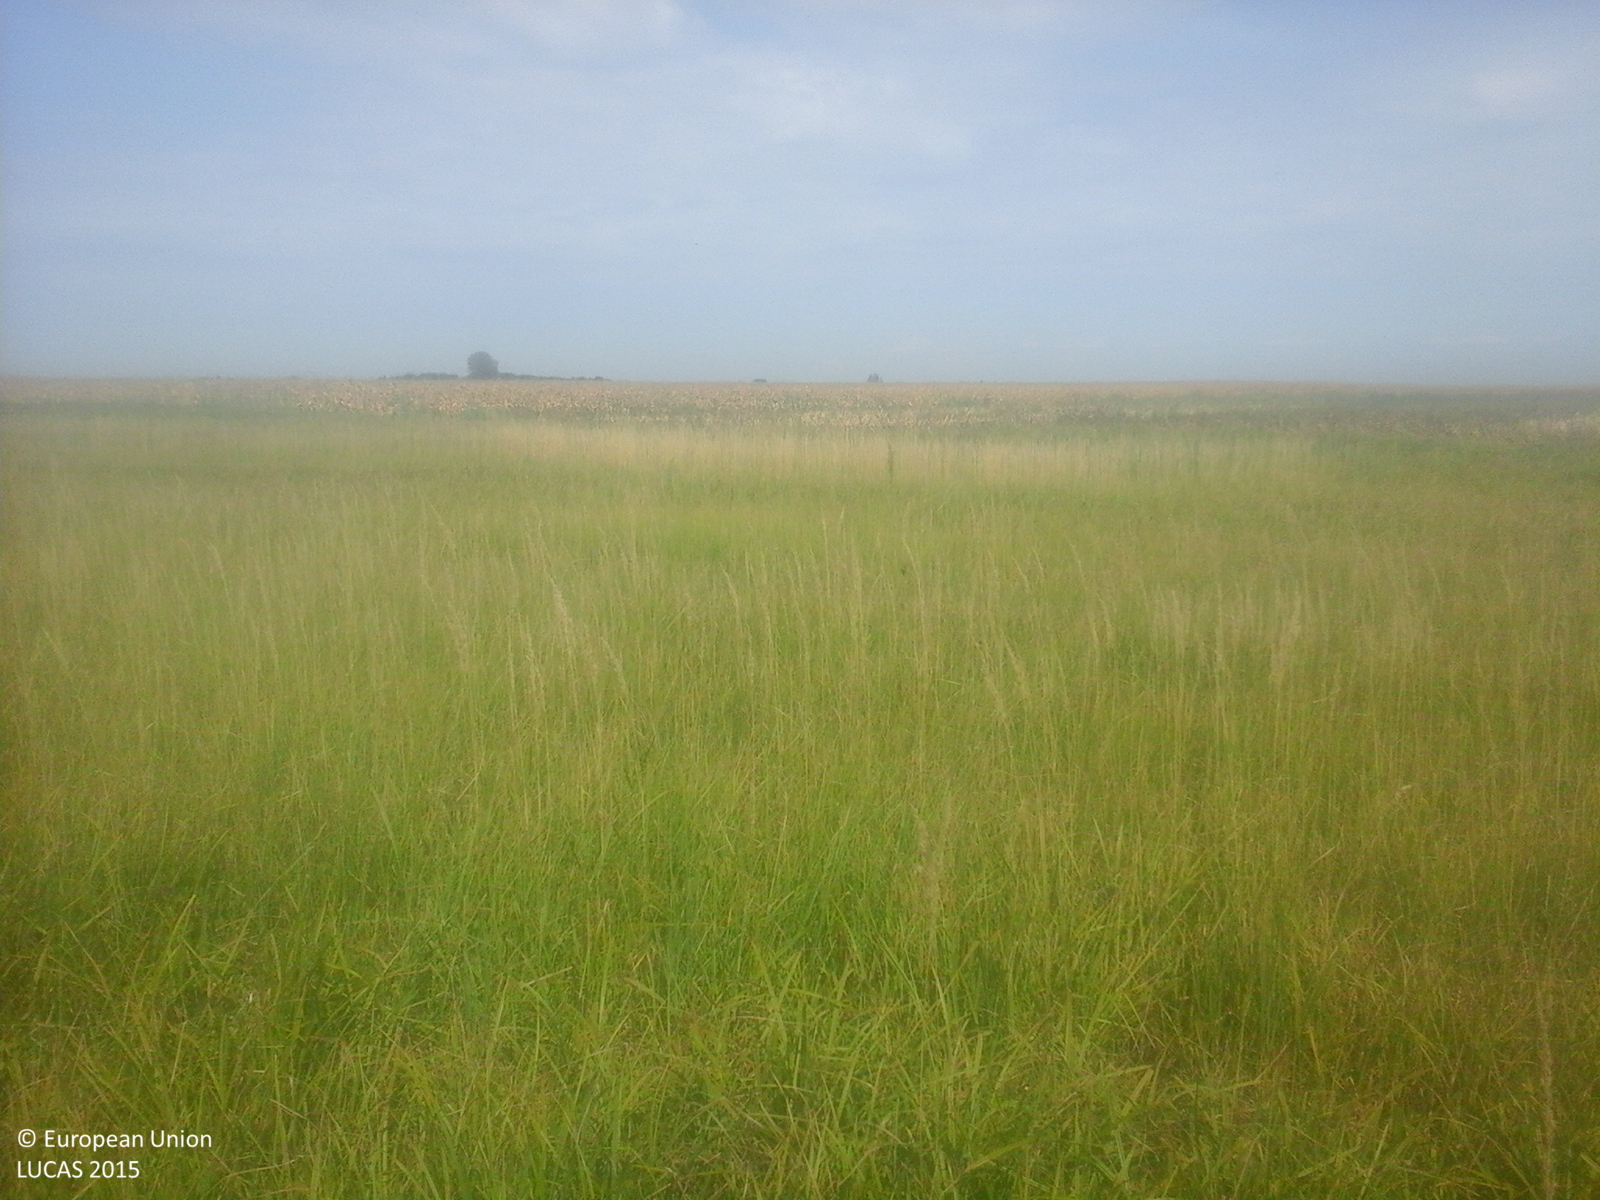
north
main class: Grassland
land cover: Spontaneously vegetated surfaces
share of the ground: > 75 %
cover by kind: herbaceous plants 100 %
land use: Fallow land
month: September
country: RO
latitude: 47.7538
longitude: 22.5854
